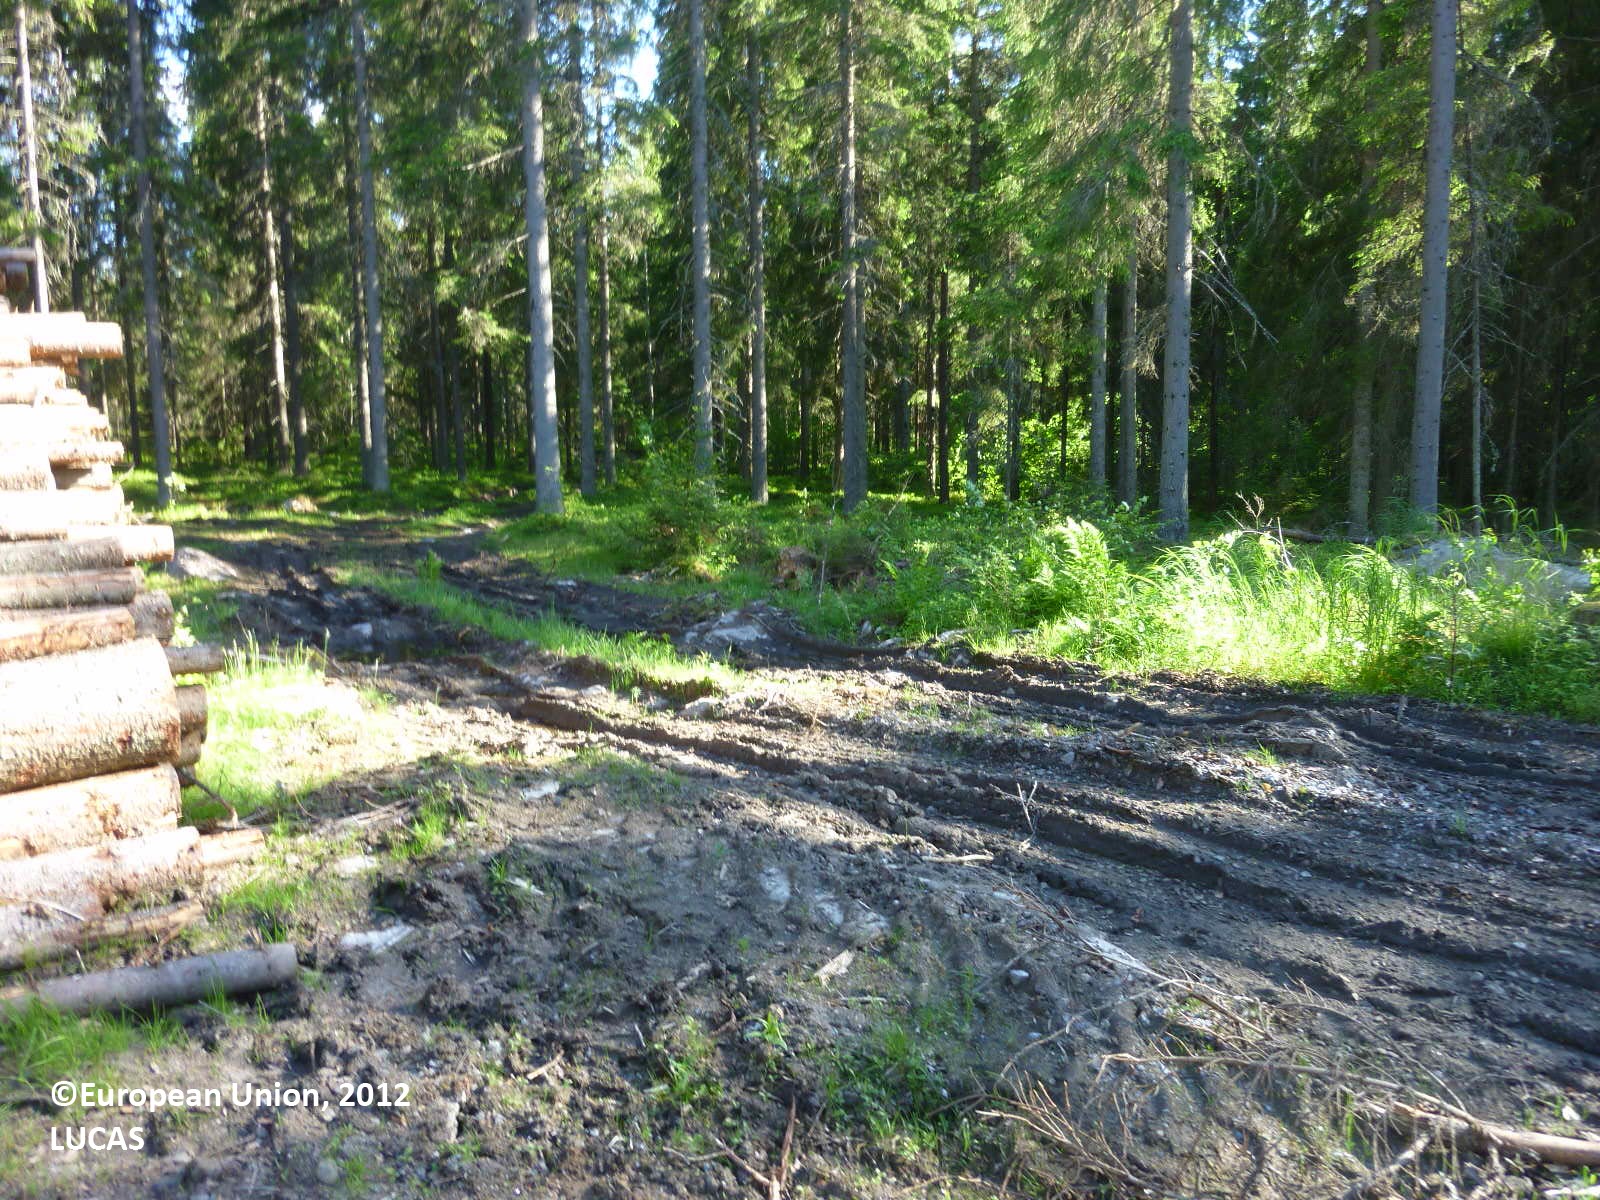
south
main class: Woodland
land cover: Spruce dominated coniferous woodland
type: boreal forest
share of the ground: > 75 %
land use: Forestry
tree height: > 5 m
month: June
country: FI
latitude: 61.6719
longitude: 22.2433
